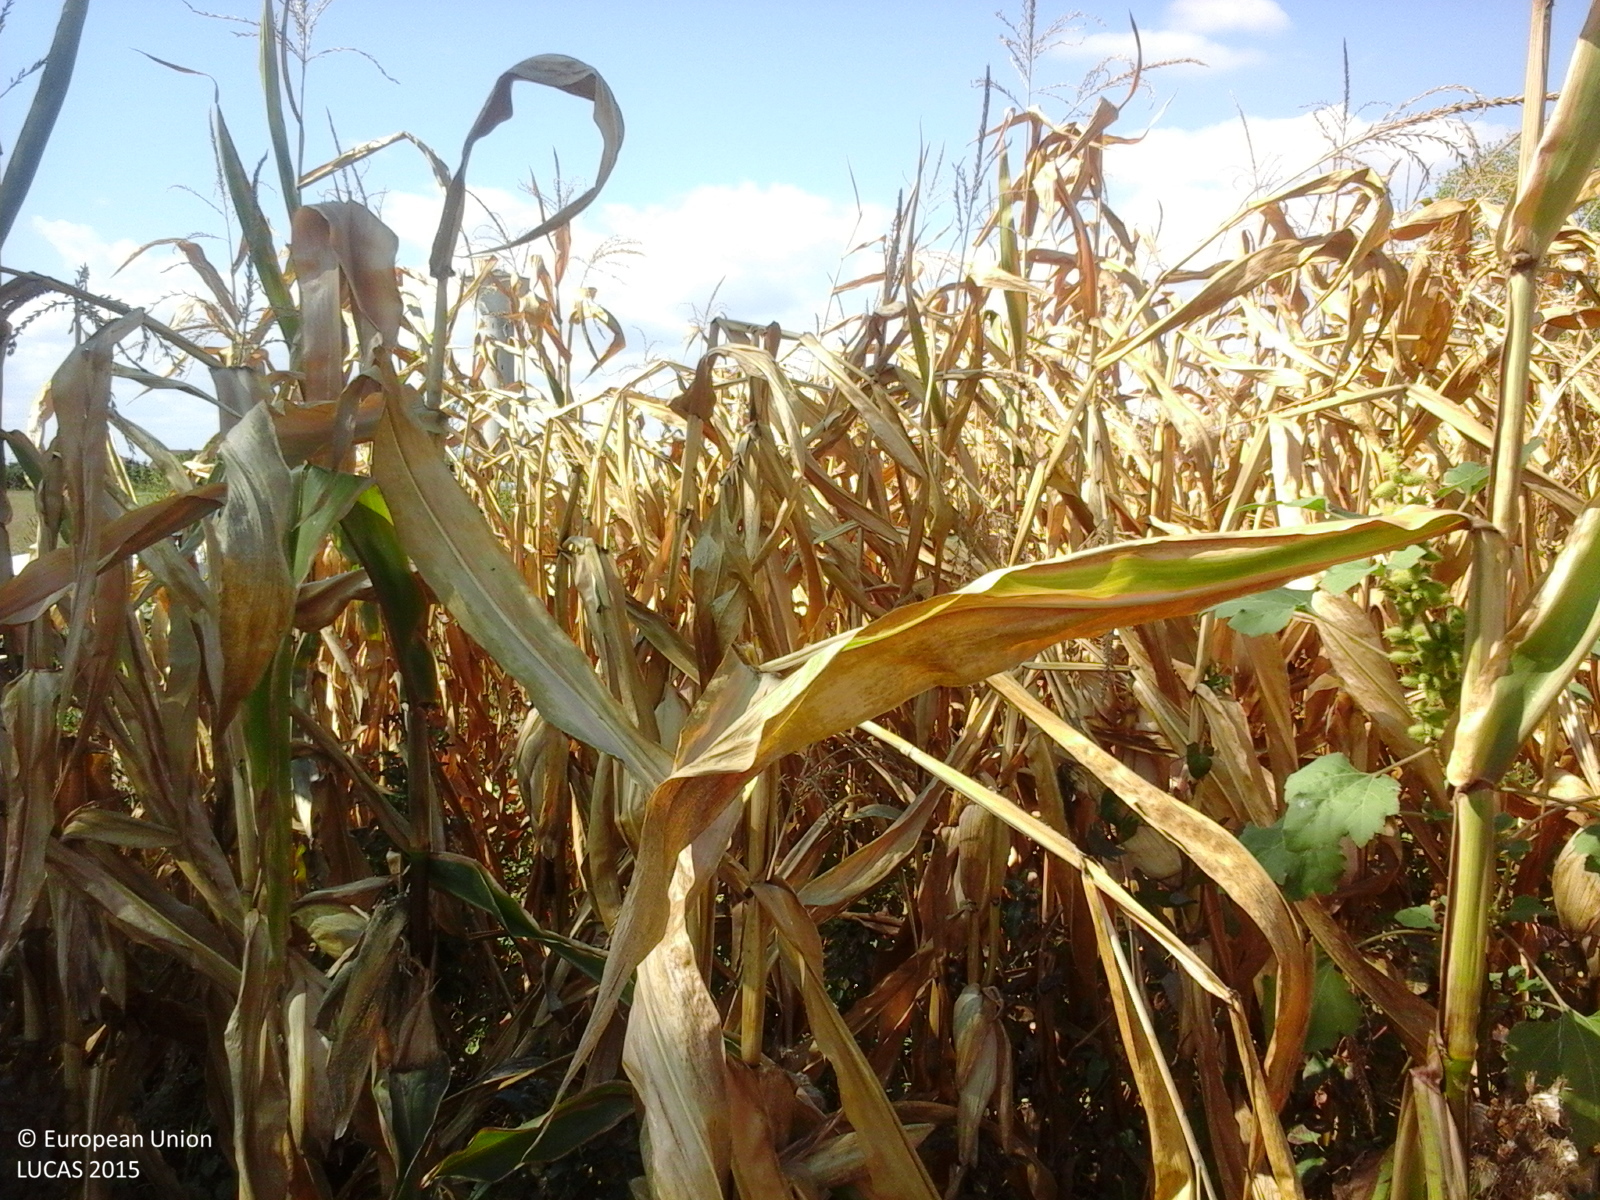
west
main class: Cropland
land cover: Maize
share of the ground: > 75 %
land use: Agriculture (excluding fallow land and kitchen gardens)
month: September
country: RO
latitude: 47.7989
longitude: 22.9766
